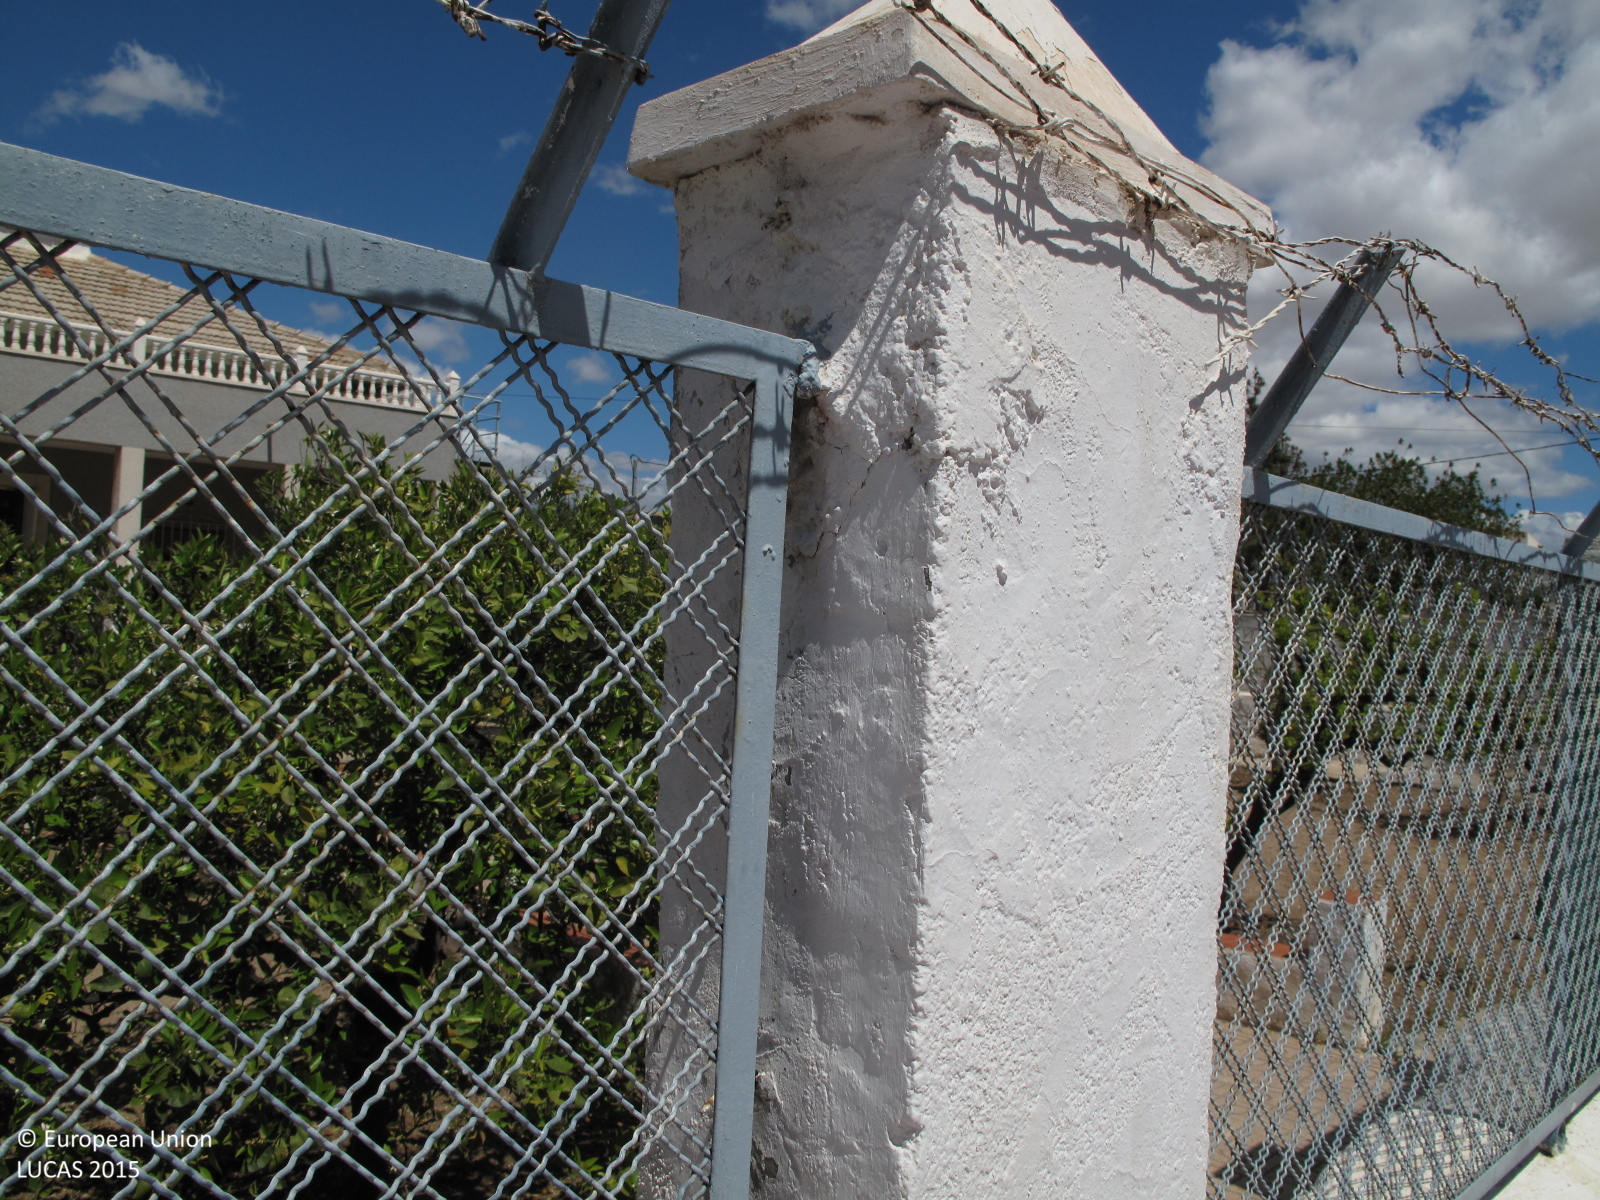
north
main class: Cropland
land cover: Oranges
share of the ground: < 10 %
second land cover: Other bare soil
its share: > 75 %
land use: Kitchen garden
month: April
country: ES
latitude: 38.3878
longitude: -0.5073
